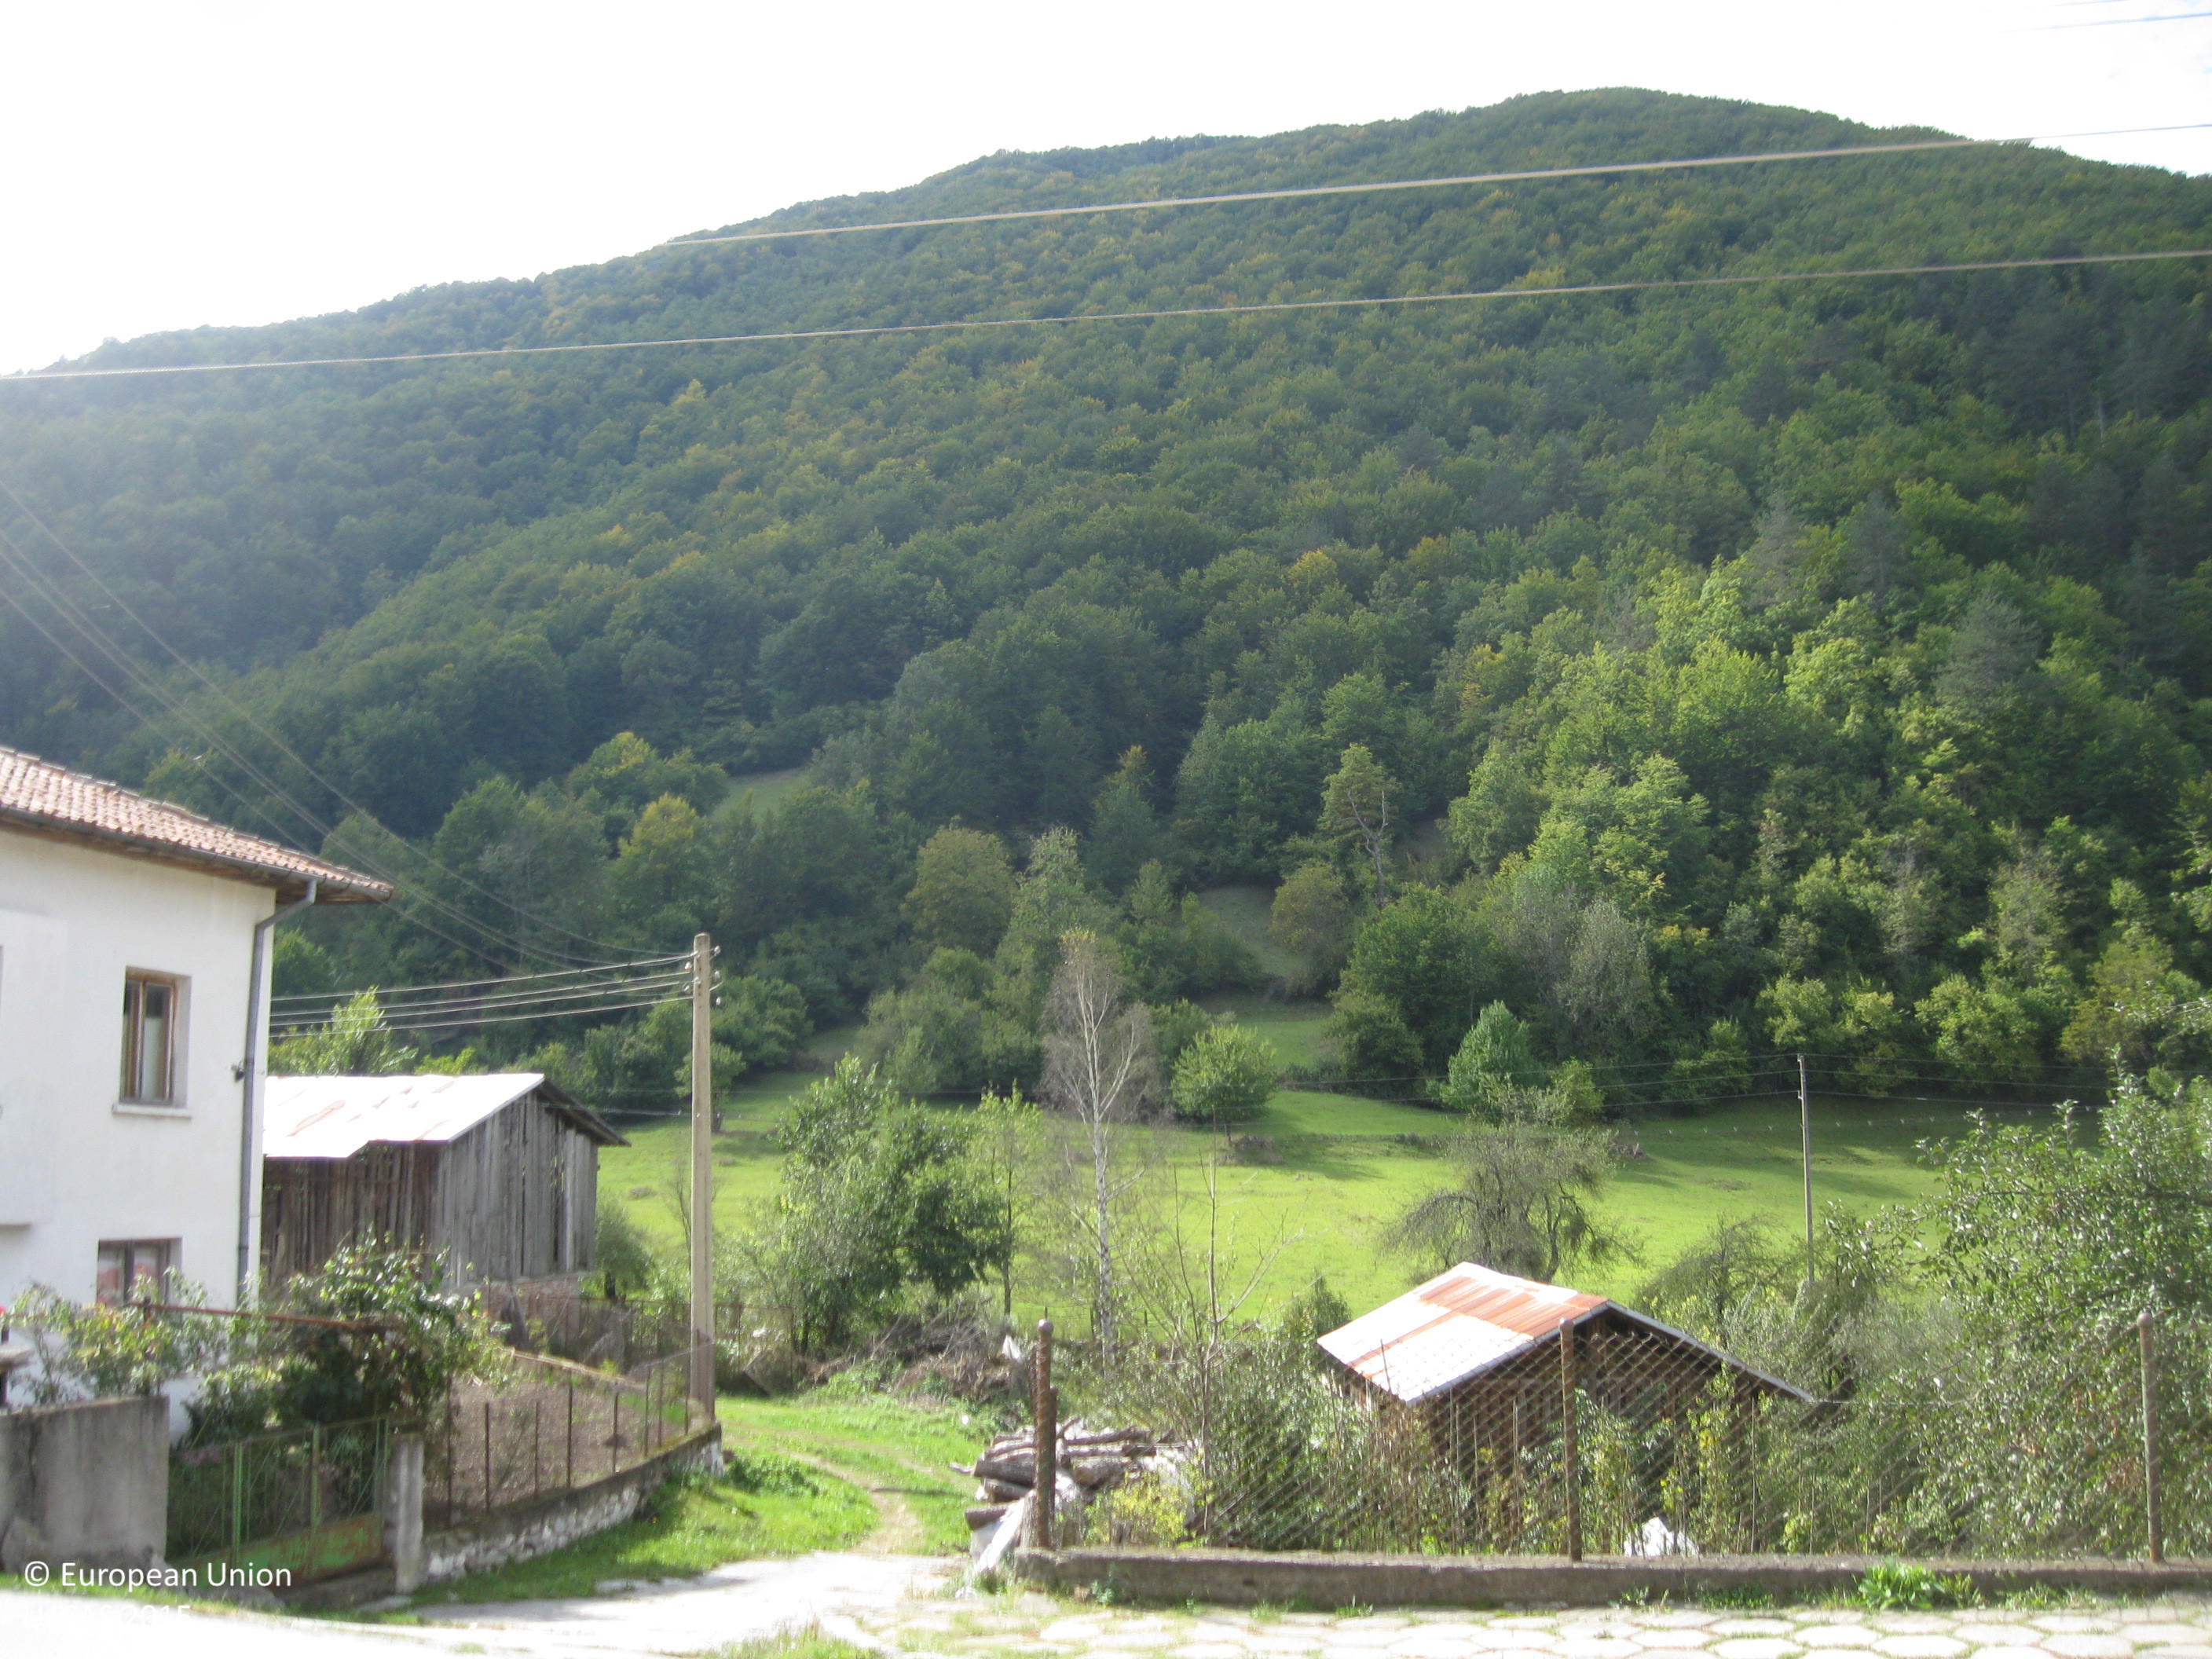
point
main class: Woodland
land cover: Pine dominated mixed woodland
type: mountainous beech forest
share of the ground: > 75 %
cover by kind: coniferous forest trees 50 %, broadleaved forest trees 45 %, shrubs 5 %
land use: Forestry
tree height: > 5 m
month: October
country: BG
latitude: 41.8207
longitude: 24.8943
